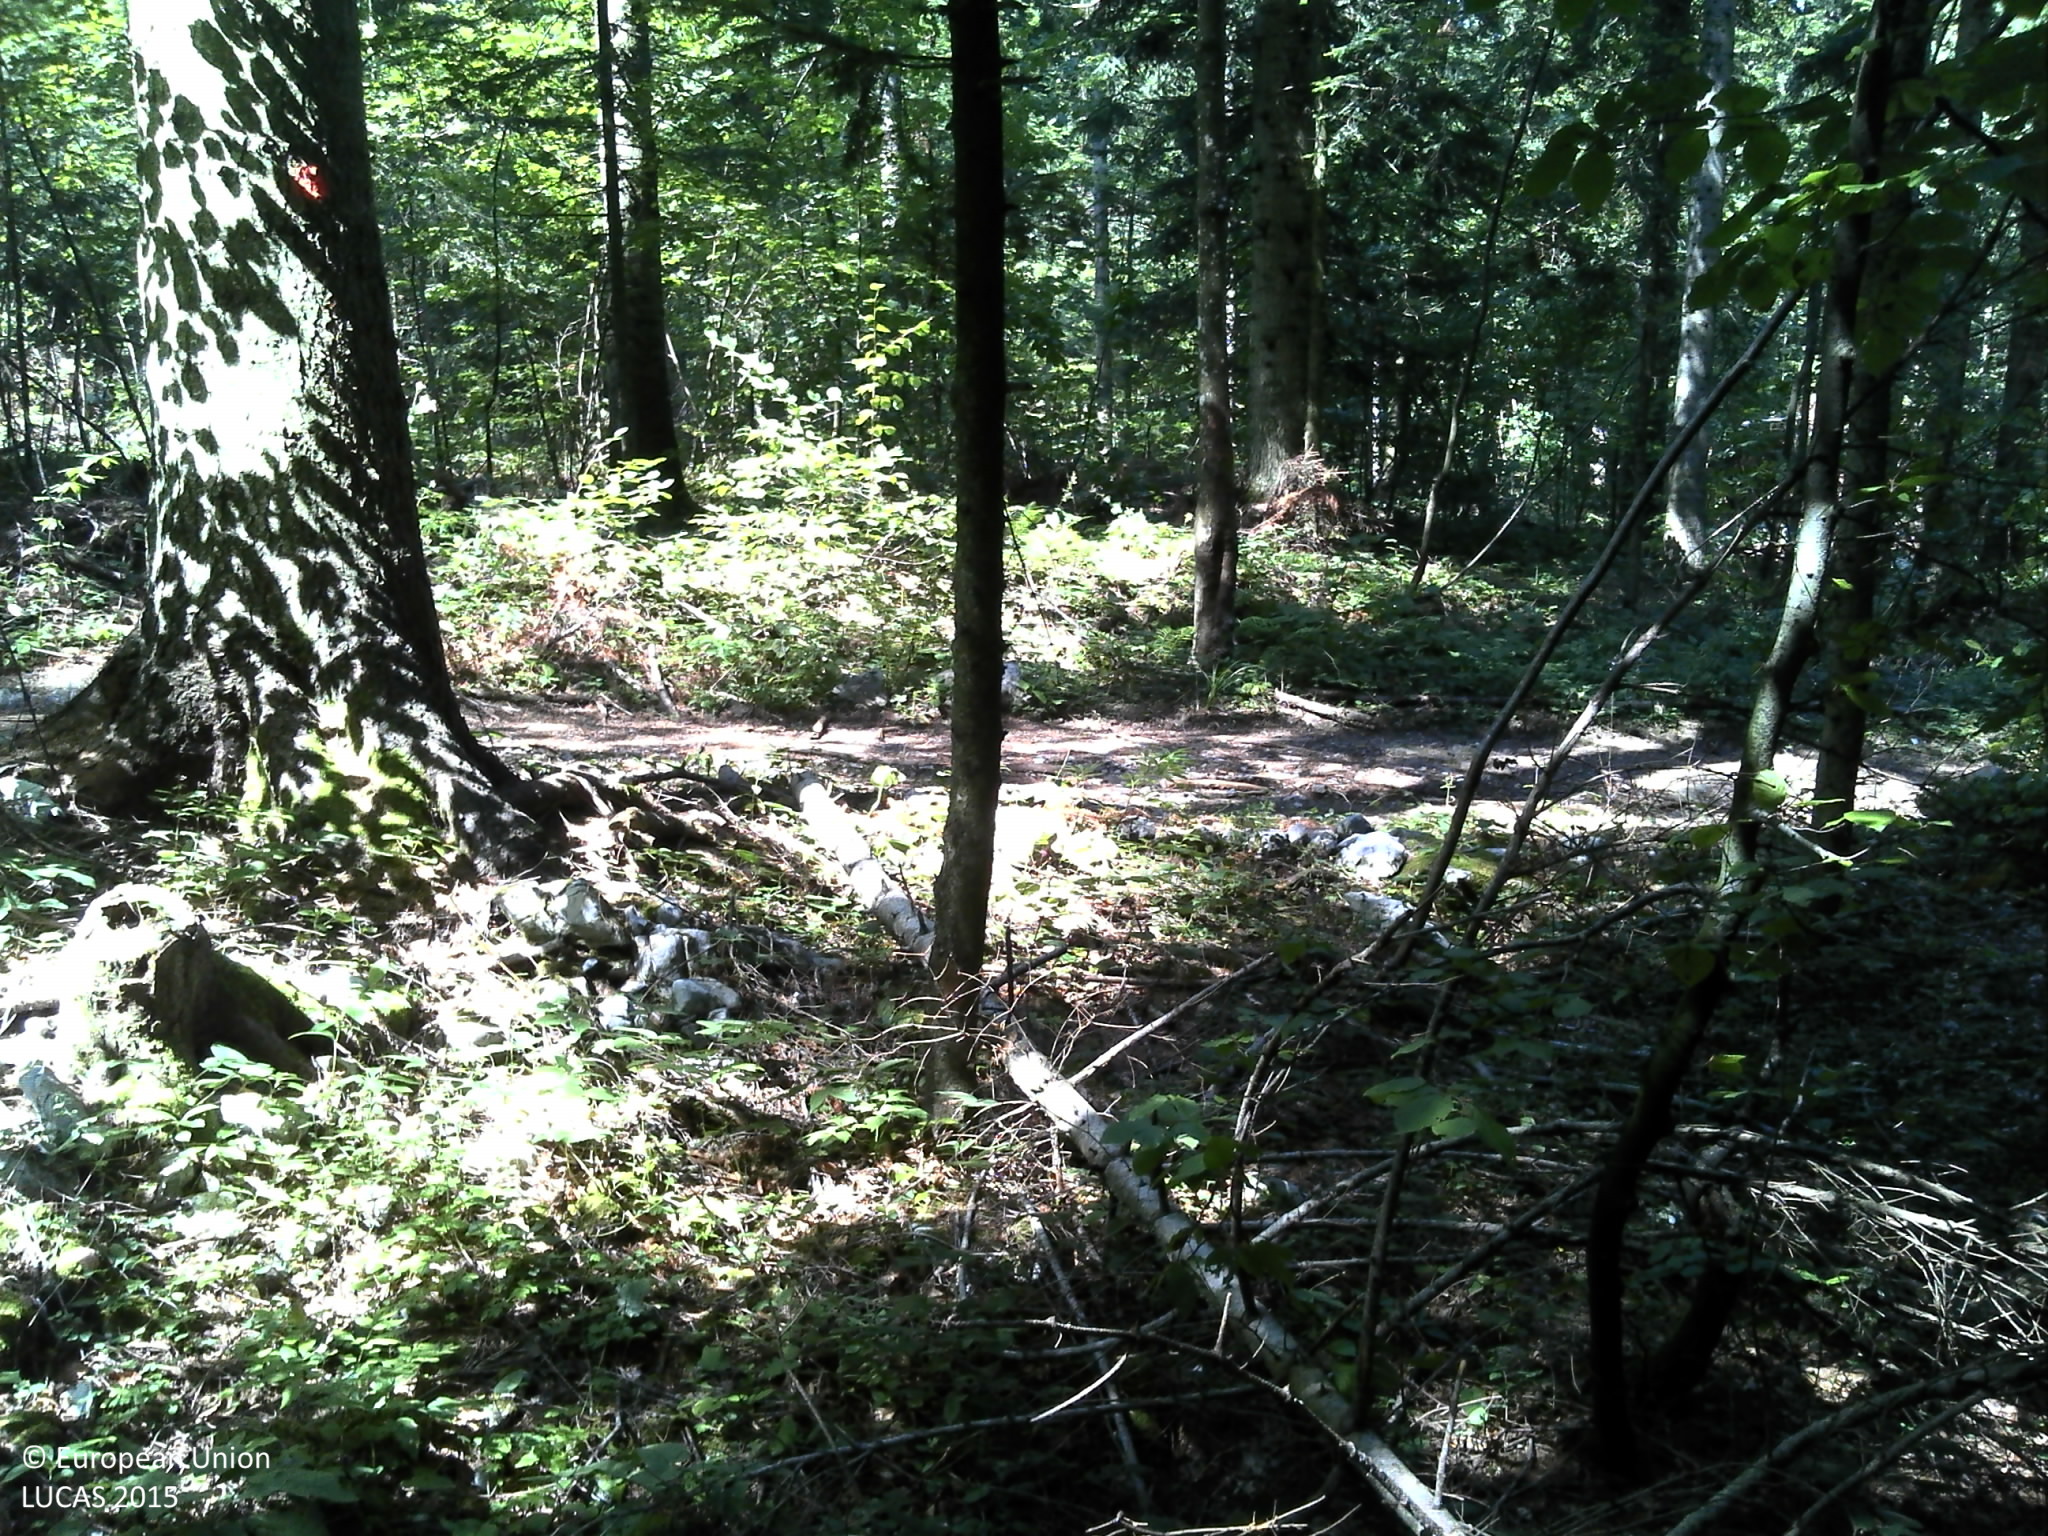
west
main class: Woodland
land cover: Pine dominated coniferous woodland
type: boreal forest
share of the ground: > 75 %
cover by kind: coniferous forest trees 100 %
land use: Forestry
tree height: > 5 m
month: August
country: HR
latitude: 45.1956
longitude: 15.2013
